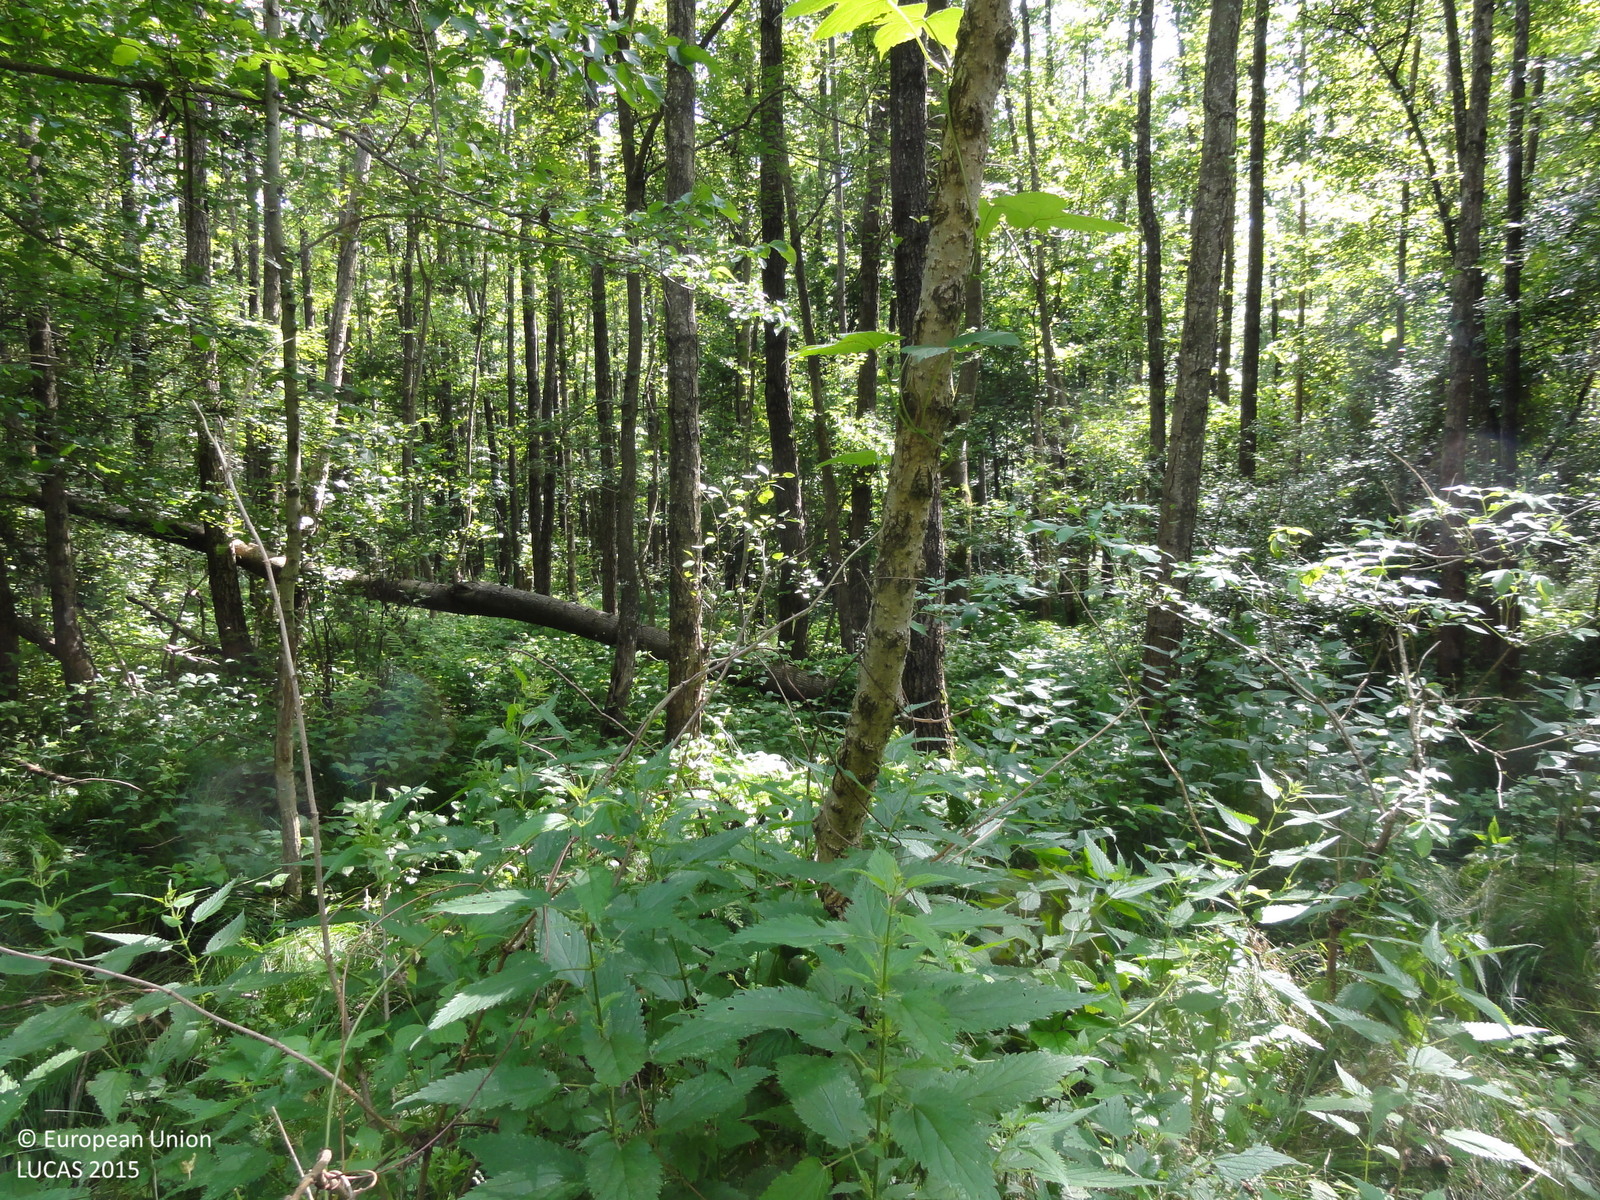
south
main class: Woodland
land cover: Broadleaved woodland
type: non-riverine alder, birch or aspen forest
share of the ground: > 75 %
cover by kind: broadleaved forest trees 95 %, herbaceous plants 5 %
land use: Forestry
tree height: > 5 m
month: June
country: SI
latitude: 46.5925
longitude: 16.4098
